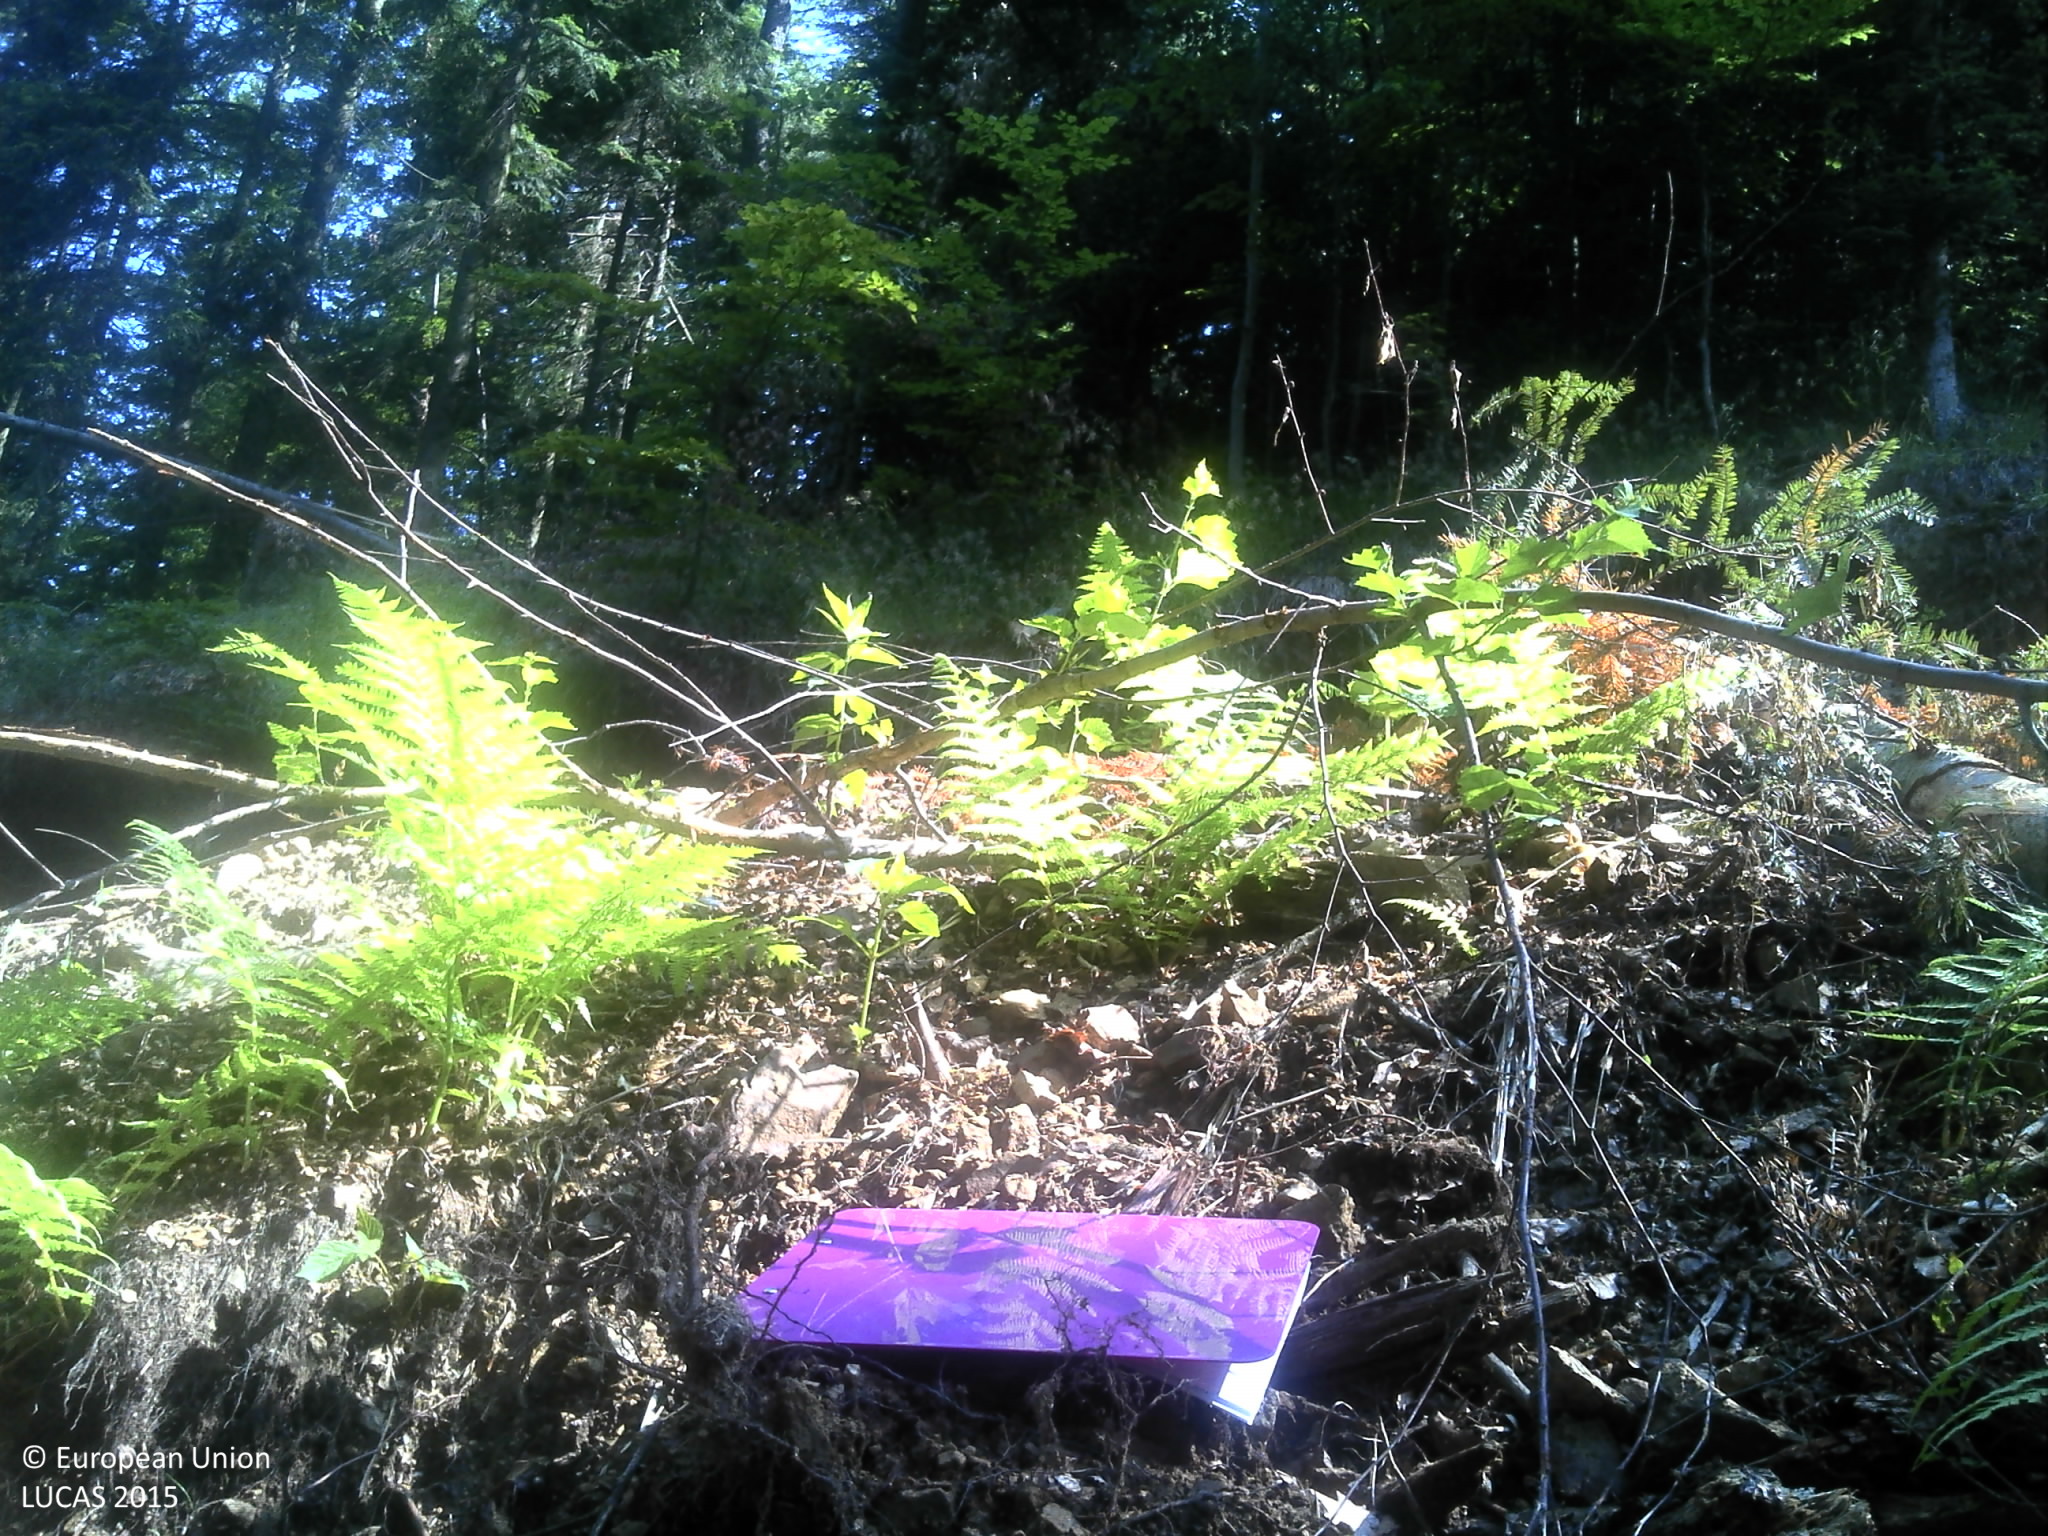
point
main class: Woodland
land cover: Pine dominated mixed woodland
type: coniferous forest of the mediterranean region
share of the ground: > 75 %
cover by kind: coniferous forest trees 70 %, broadleaved forest trees 30 %
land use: Forestry
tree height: > 5 m
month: June
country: HR
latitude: 45.5812
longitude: 17.4992
